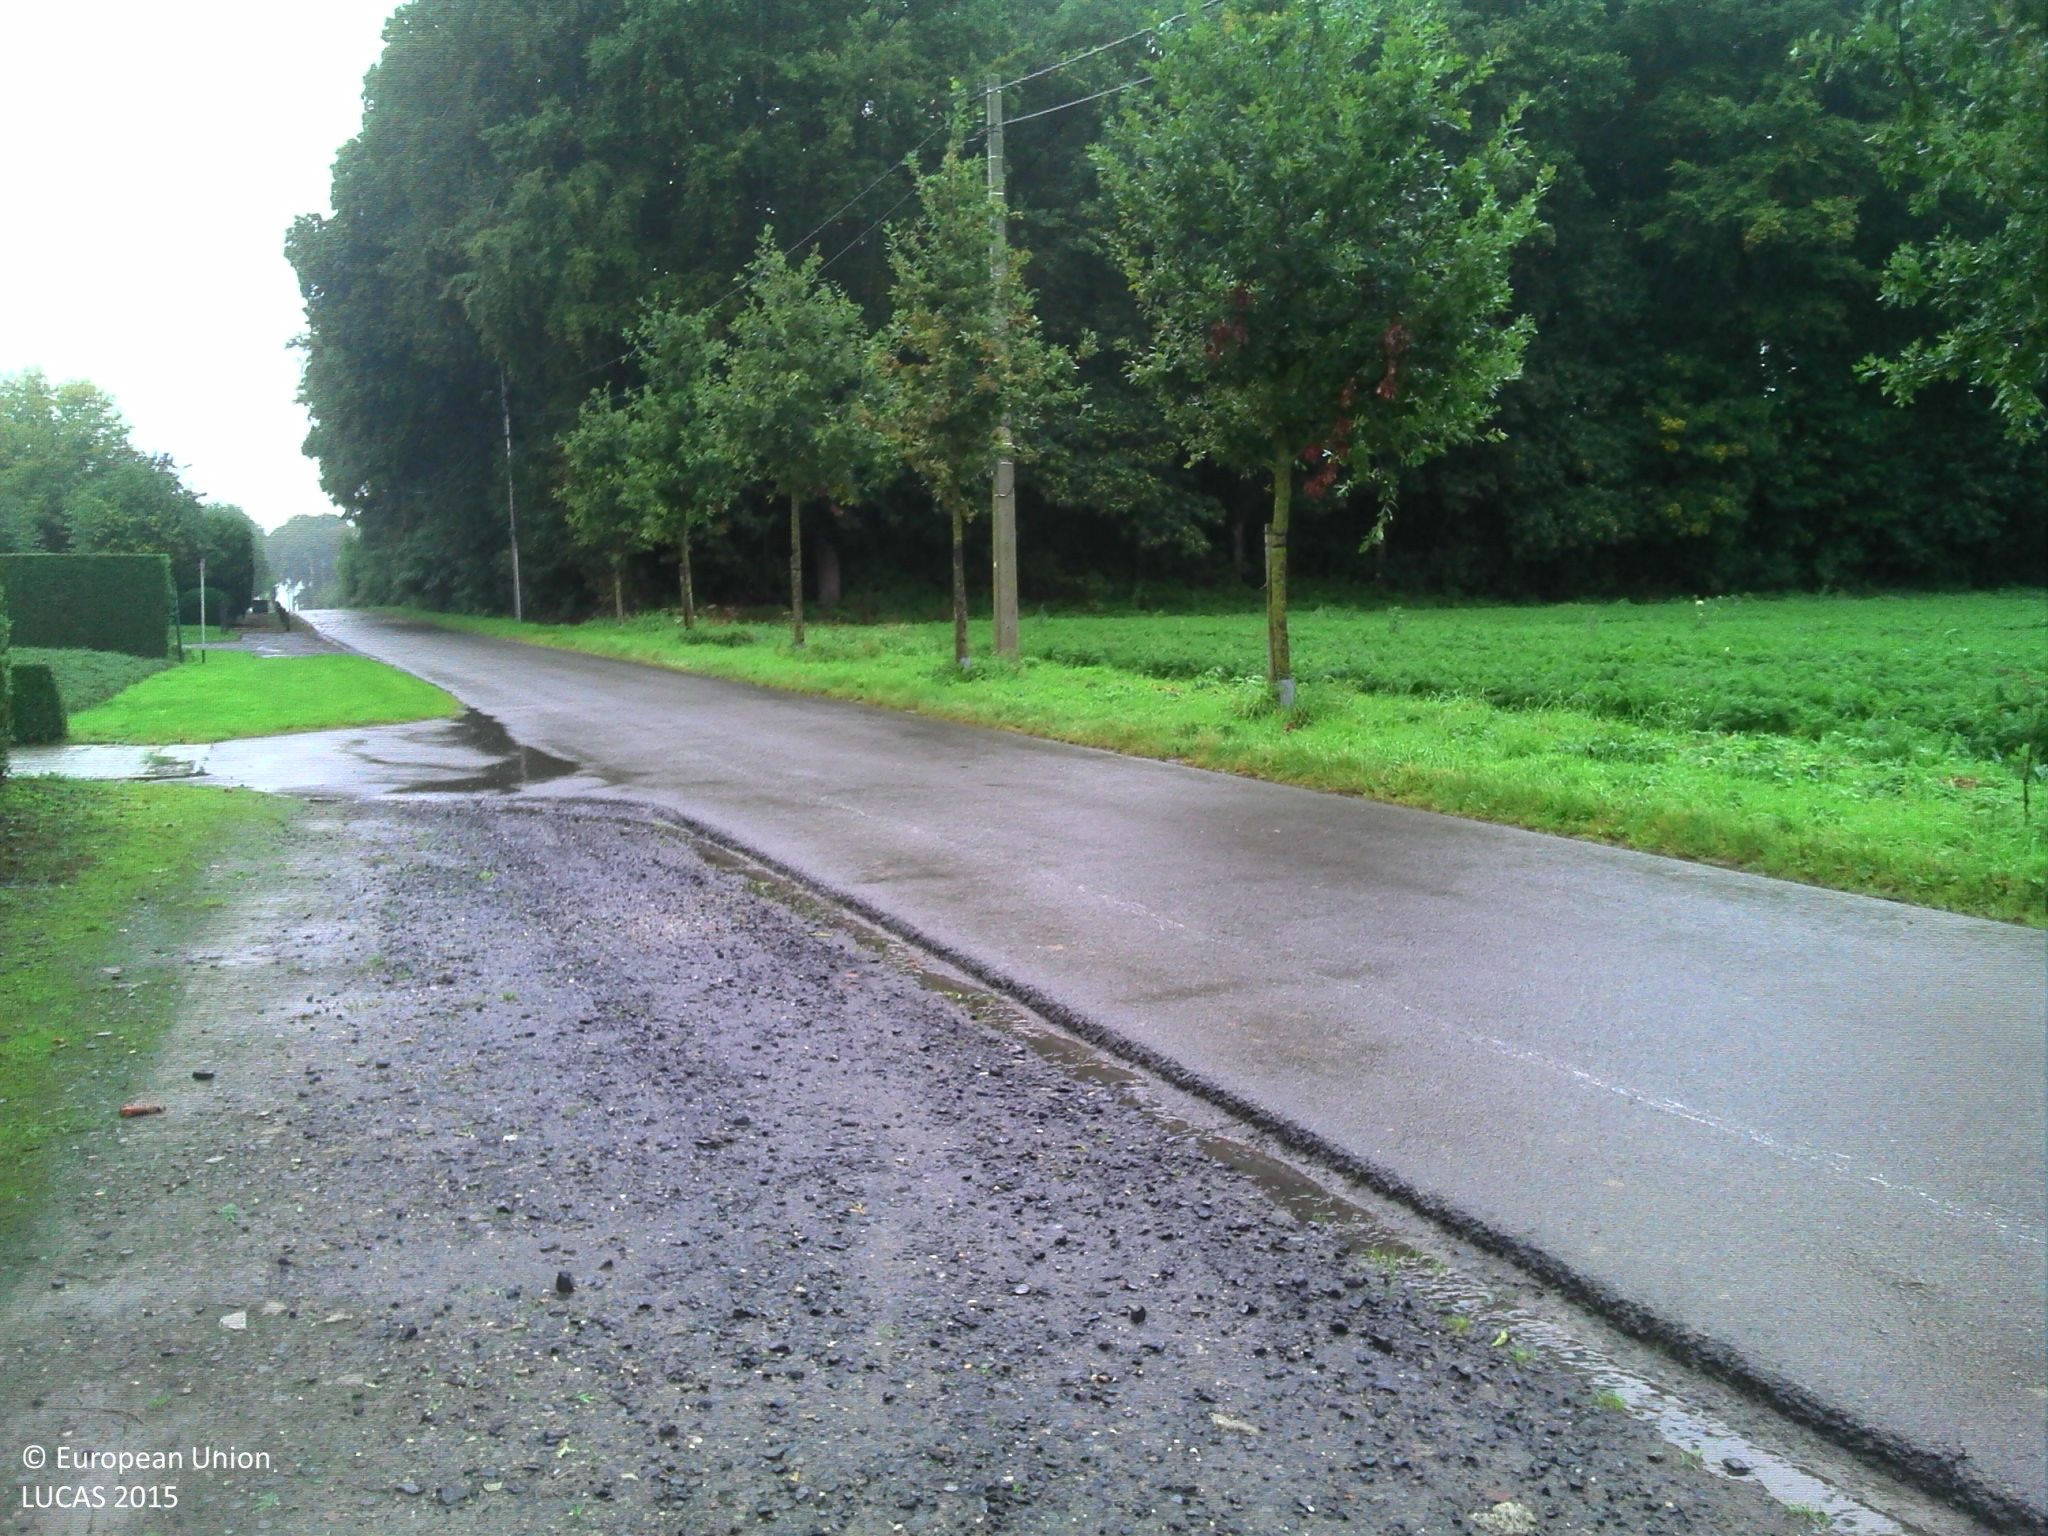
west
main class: Grassland
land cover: Grassland without tree/shrub cover
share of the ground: > 75 %
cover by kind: herbaceous plants 100 %
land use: Residential
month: October
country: BE
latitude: 50.9565
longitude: 2.9140
